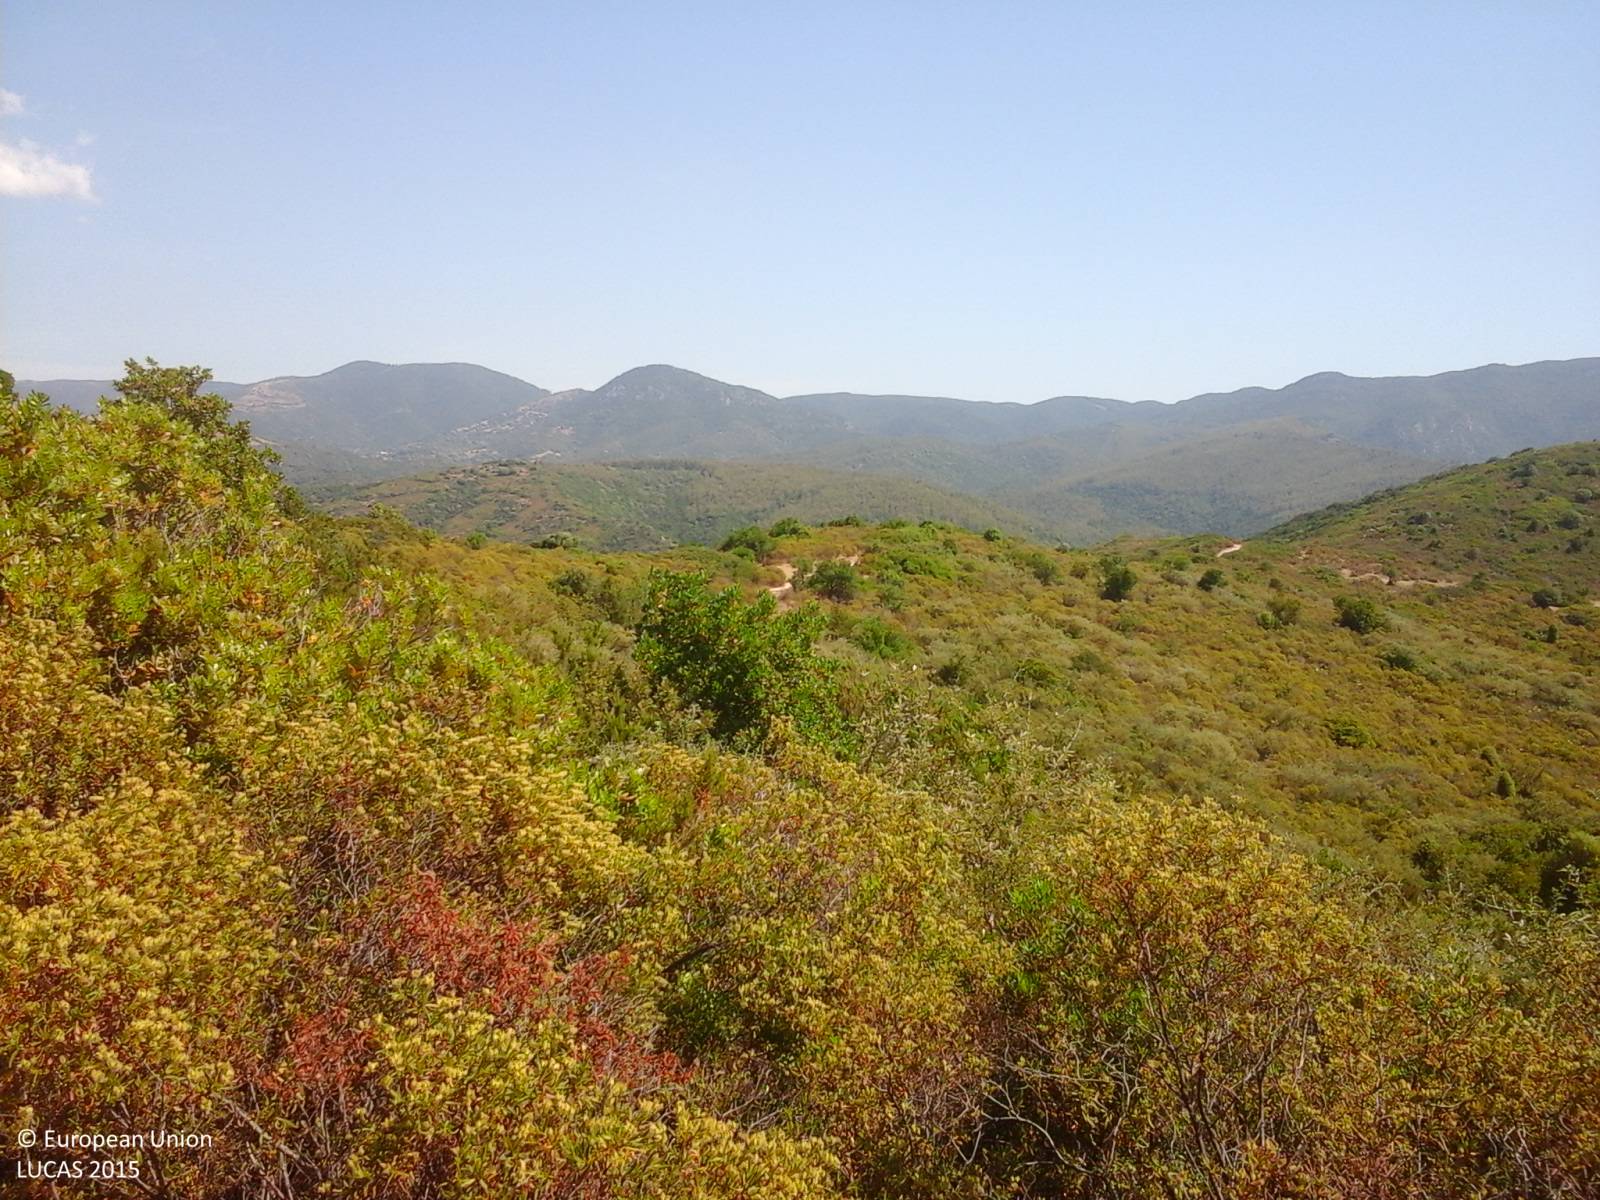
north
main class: Shrubland
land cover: Shrubland without tree cover
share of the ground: > 75 %
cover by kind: shrubs 90 %, herbaceous plants 10 %
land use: Semi-natural and natural areas not in use
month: June
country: IT
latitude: 38.9561
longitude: 8.8420
